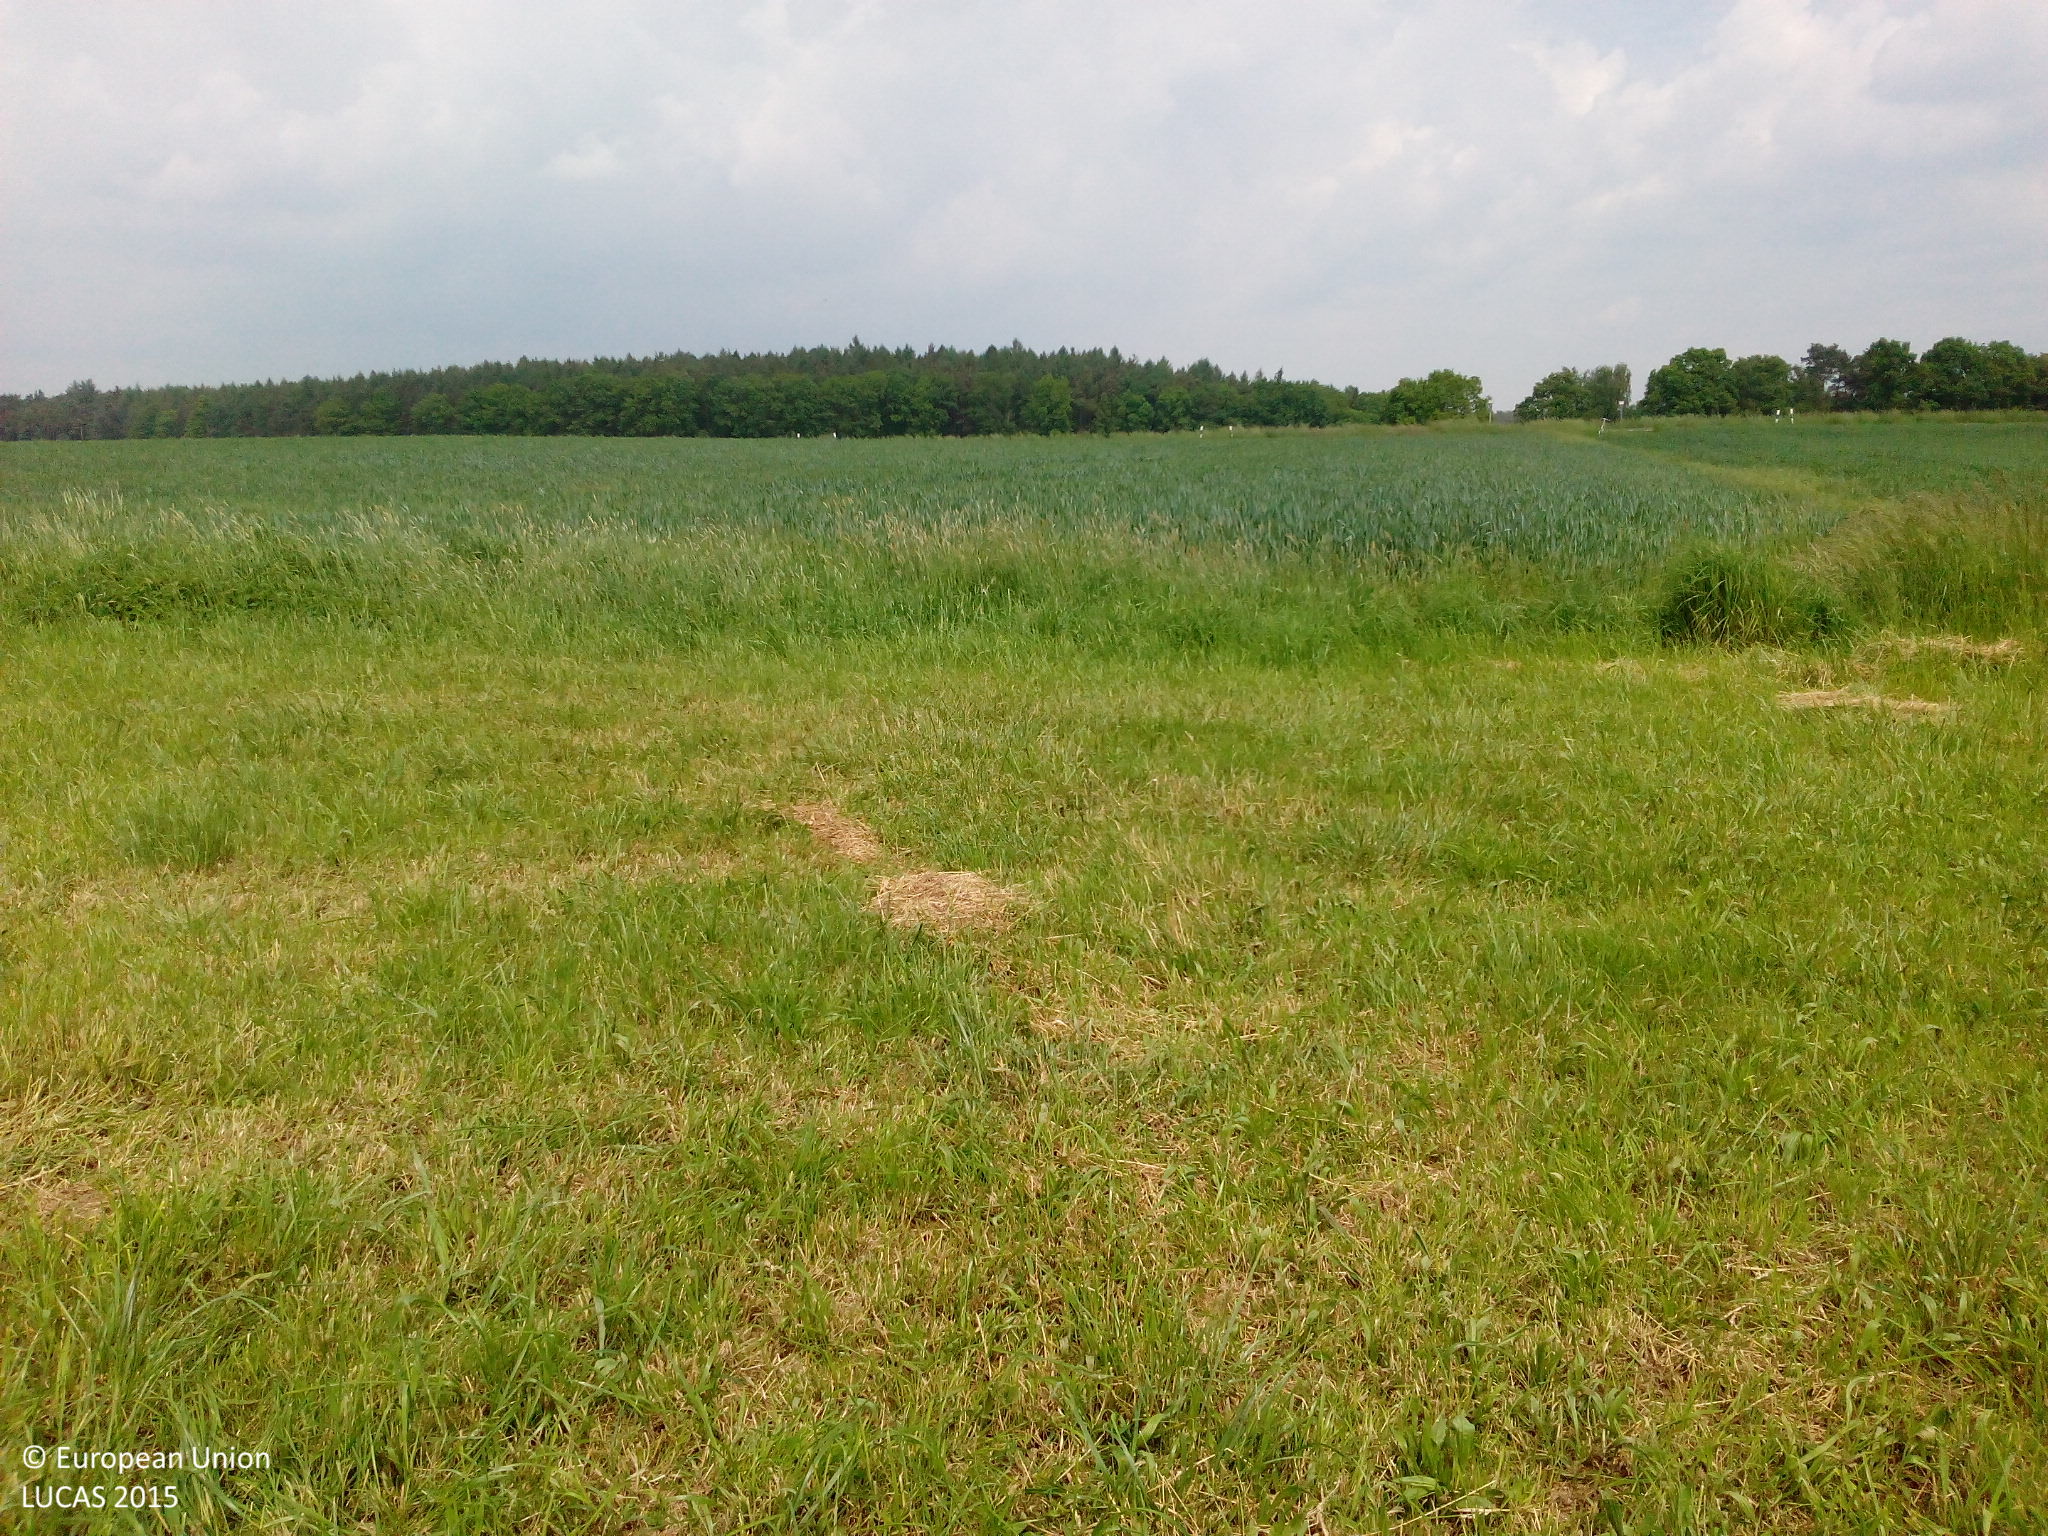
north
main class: Grassland
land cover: Grassland without tree/shrub cover
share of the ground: > 75 %
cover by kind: herbaceous plants 95 %, unconsolidated bare surface 5 %
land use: Agriculture (excluding fallow land and kitchen gardens)
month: May
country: DE
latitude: 49.1395
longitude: 12.0966
